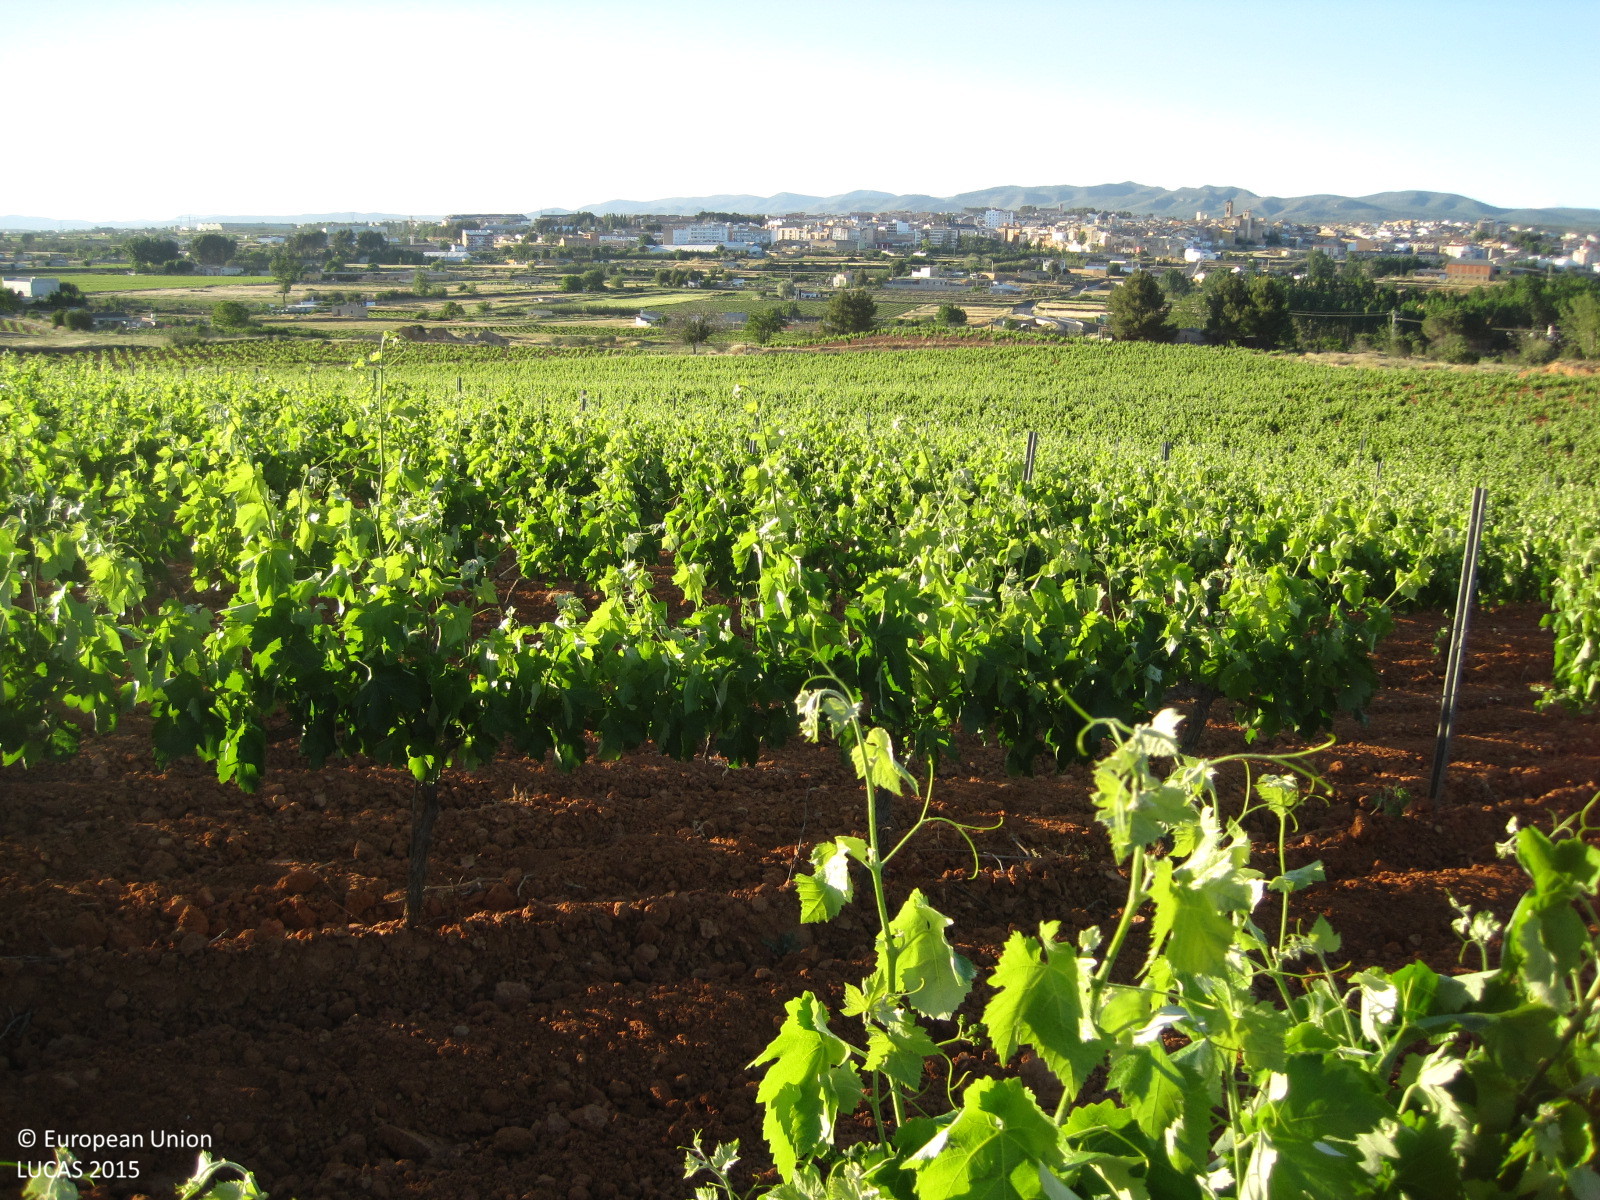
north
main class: Artificial land
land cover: Other artificial areas
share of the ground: > 75 %
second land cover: Vineyards
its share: 25 - 50 %
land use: Electricity, gas and thermal power distribution
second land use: Agriculture (excluding fallow land and kitchen gardens)
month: May
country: ES
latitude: 39.4709
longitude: -1.1021
